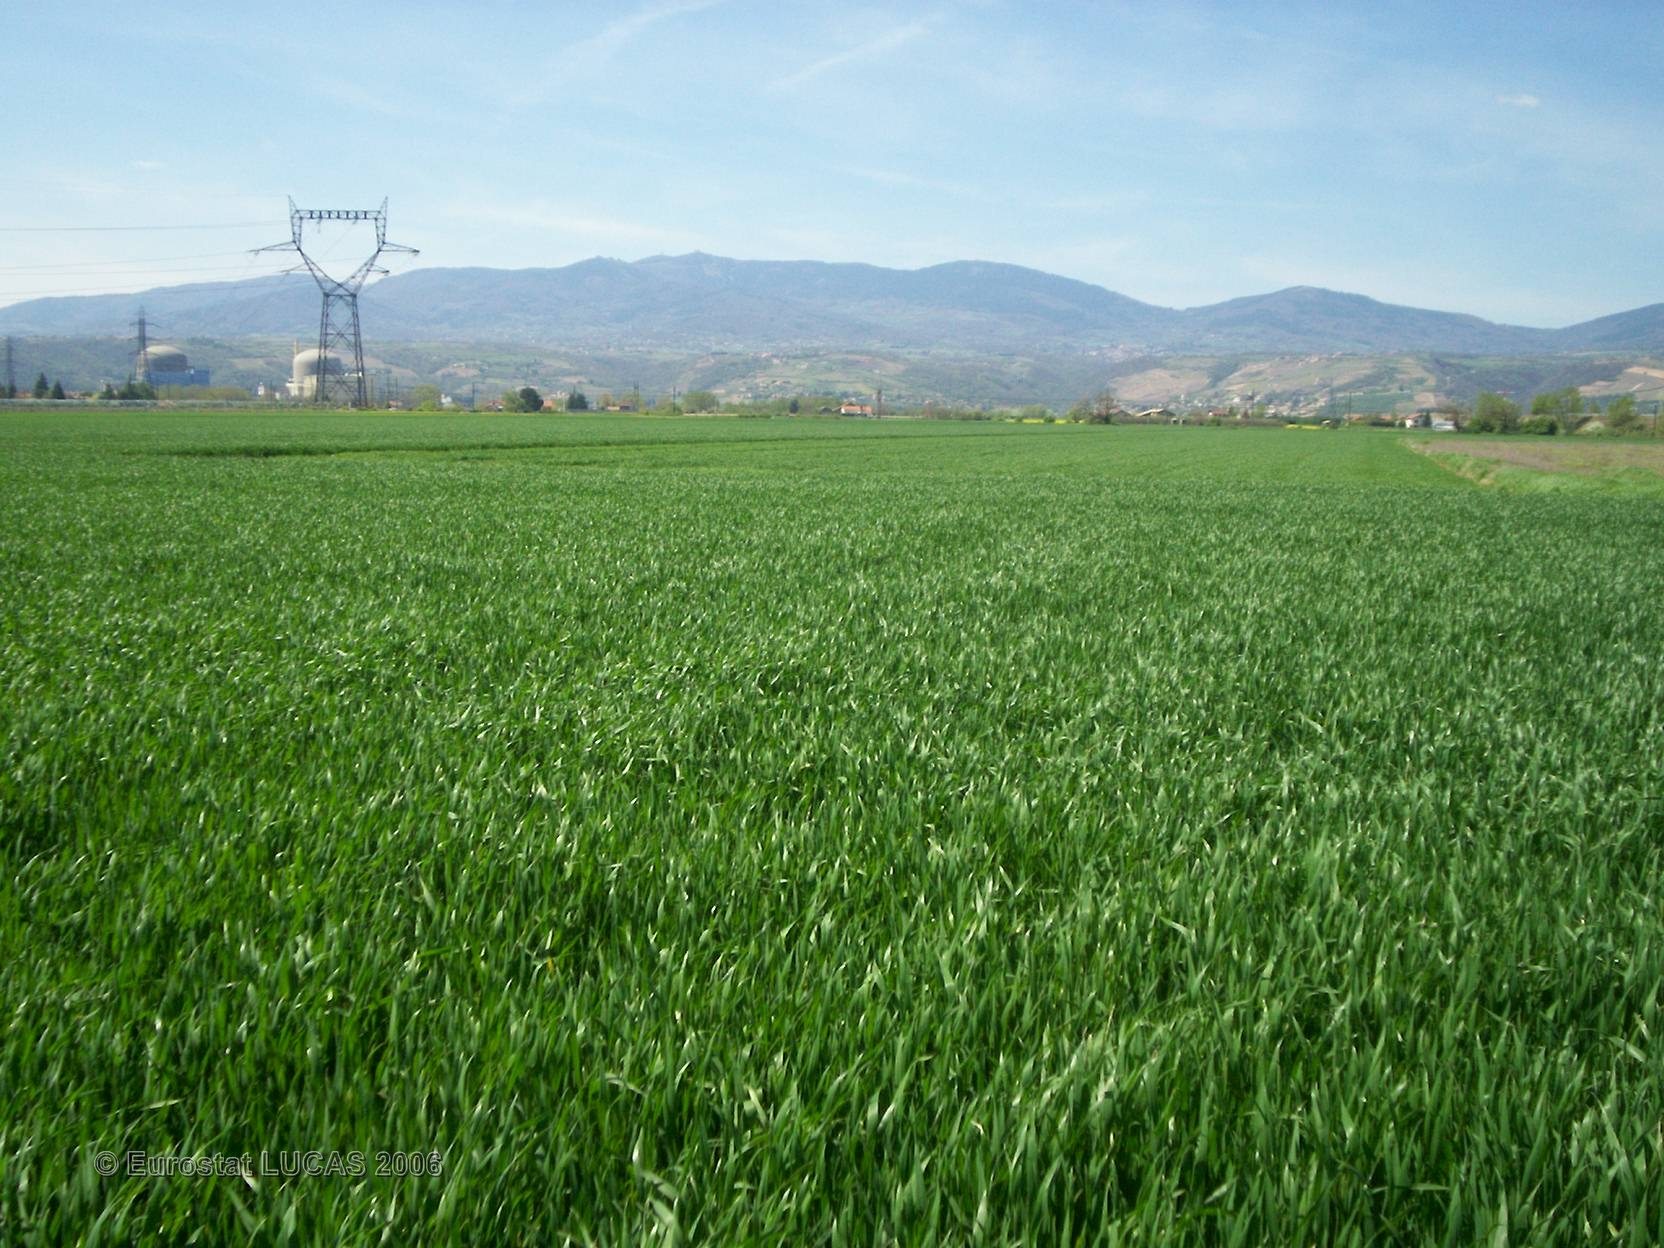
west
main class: Cropland
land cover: Triticale
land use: Agriculture (excluding fallow land and kitchen gardens)
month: April
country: FR
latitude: 45.4113
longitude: 4.7783
